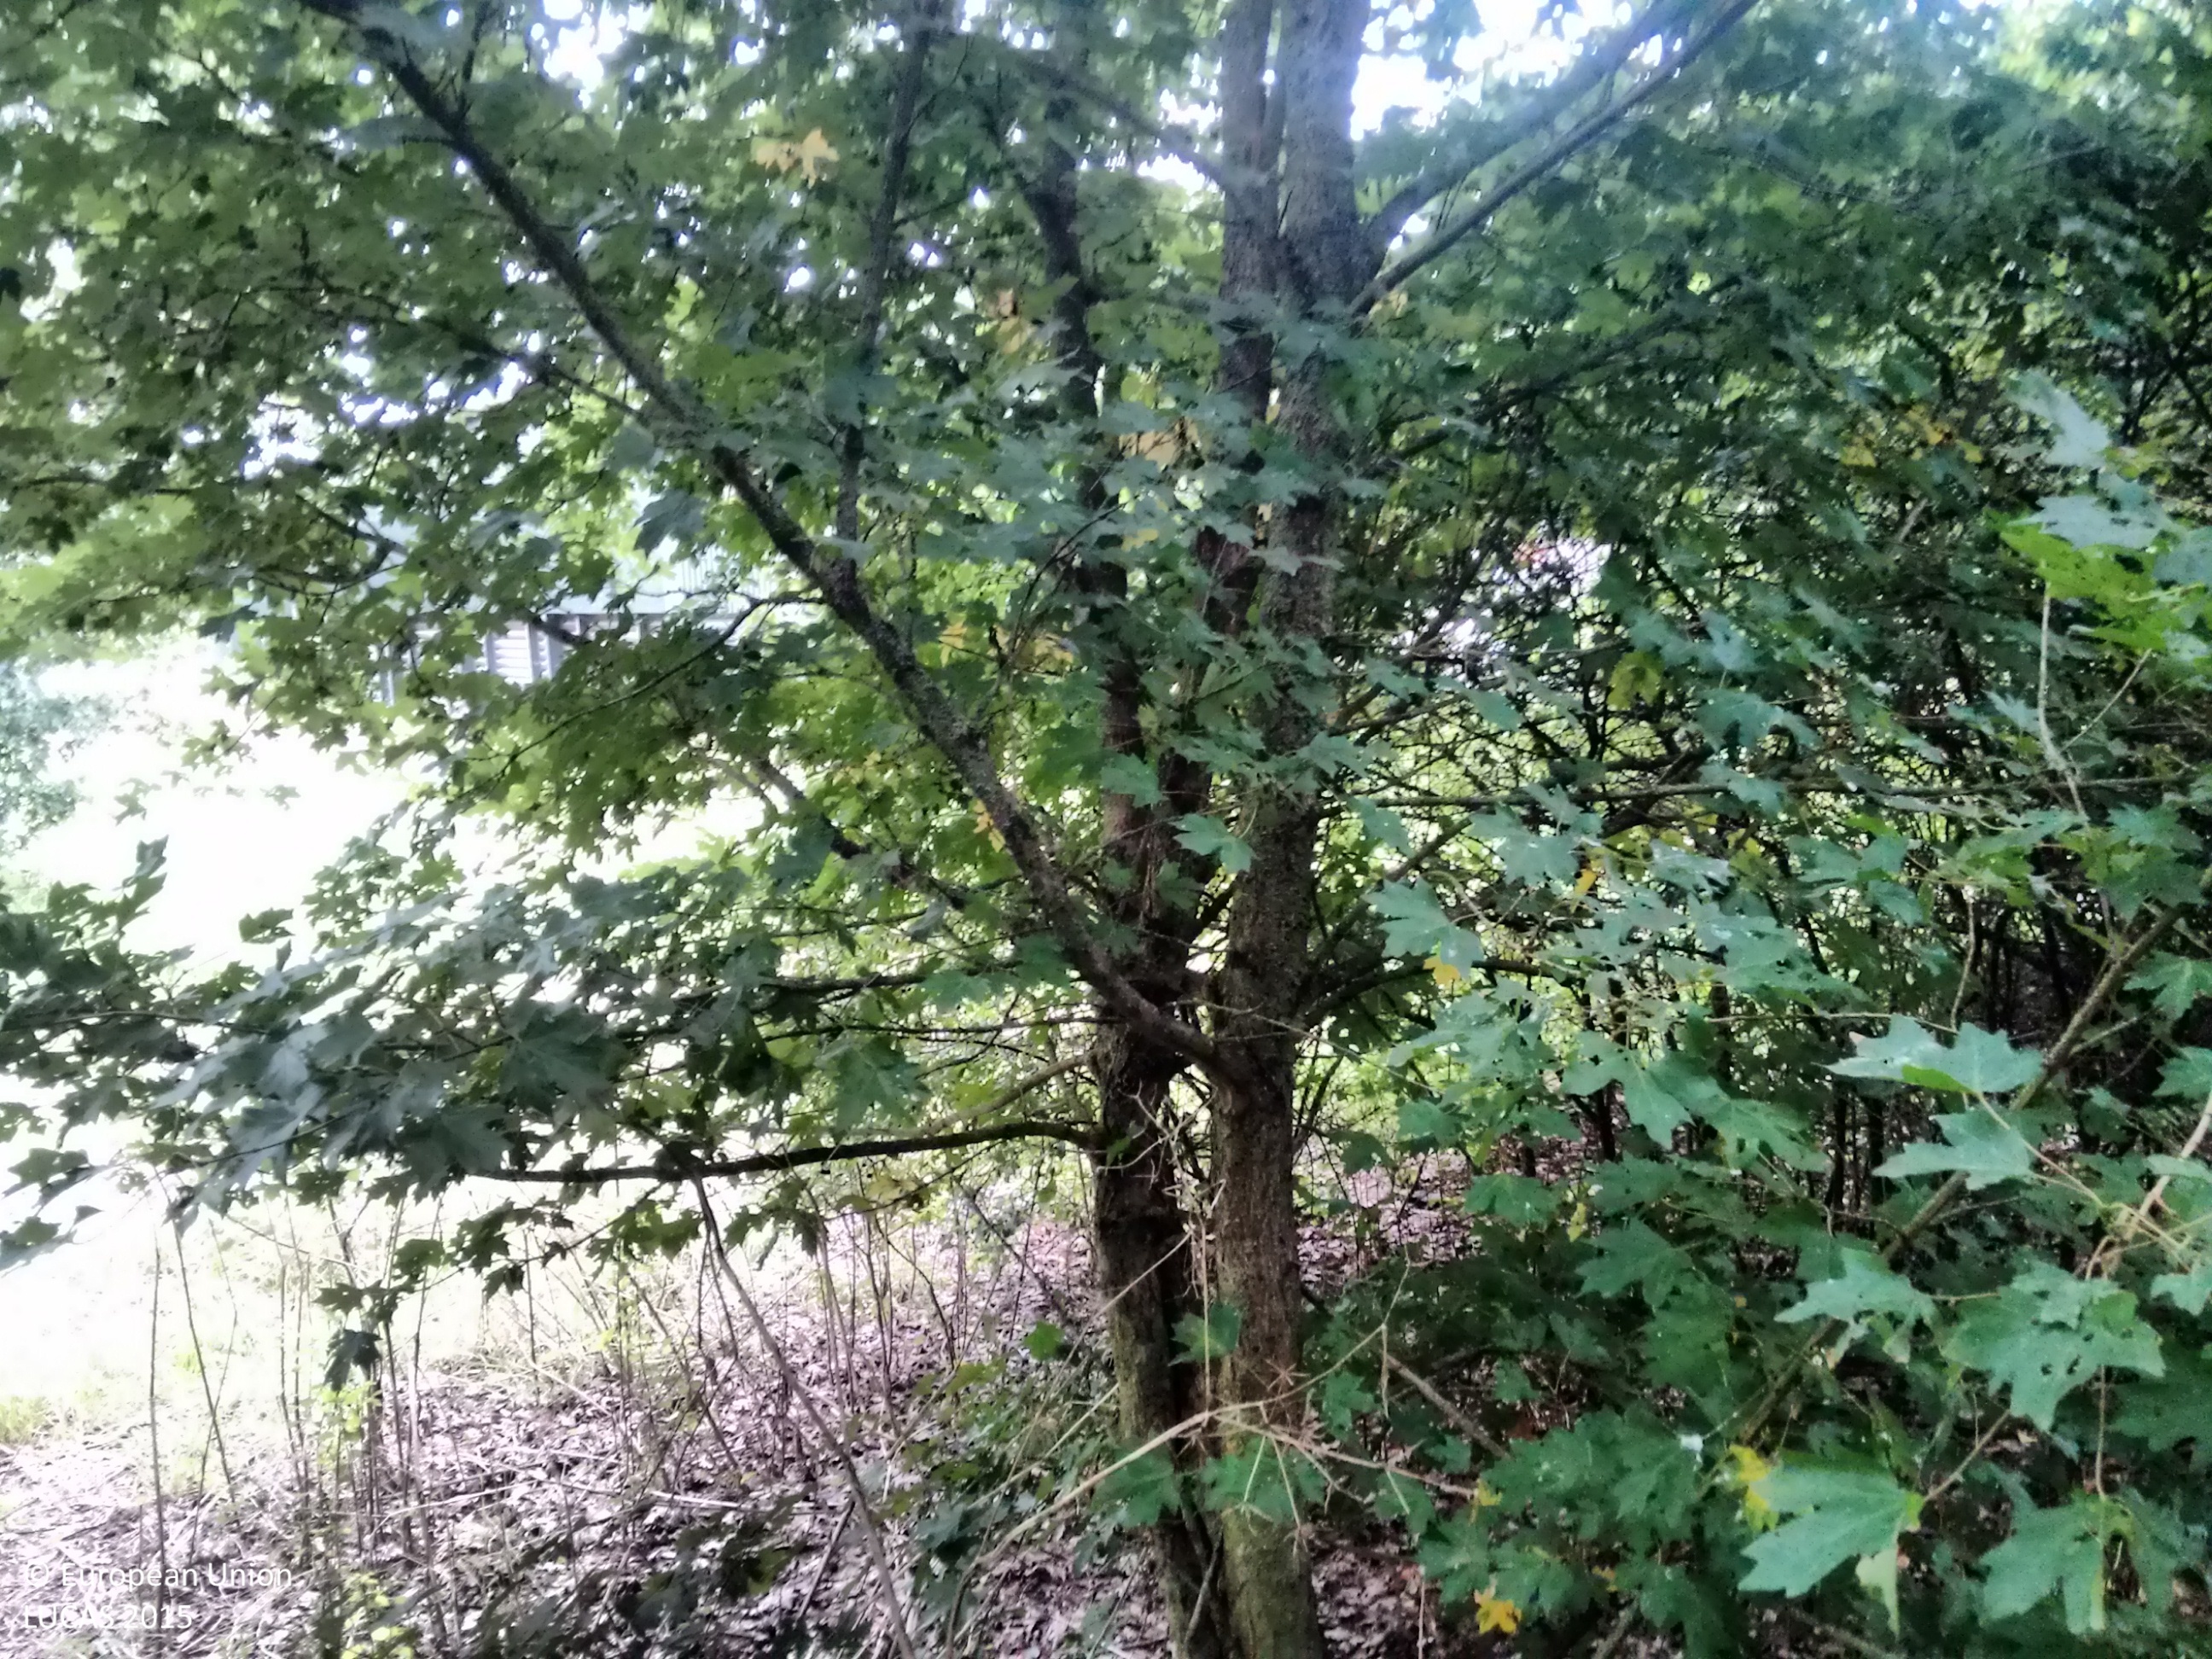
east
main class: Woodland
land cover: Broadleaved woodland
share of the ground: > 75 %
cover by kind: broadleaved forest trees 75 %, shrubs 25 %
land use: Semi-natural and natural areas not in use
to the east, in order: Broadleaved woodland; Artificial constructions in urban areas; Grassland with sparse tree/shrub cover; Tracks; Grassland with sparse tree/shrub cover; Ditches and canals; Shrubland without tree cover; Tracks; Grassland without tree/shrub cover; Common wheat; Grass margins; Tracks; Grass margins; Managed hedges; Grassland without tree/shrub cover
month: September
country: GB
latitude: 52.2679
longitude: 0.2842
